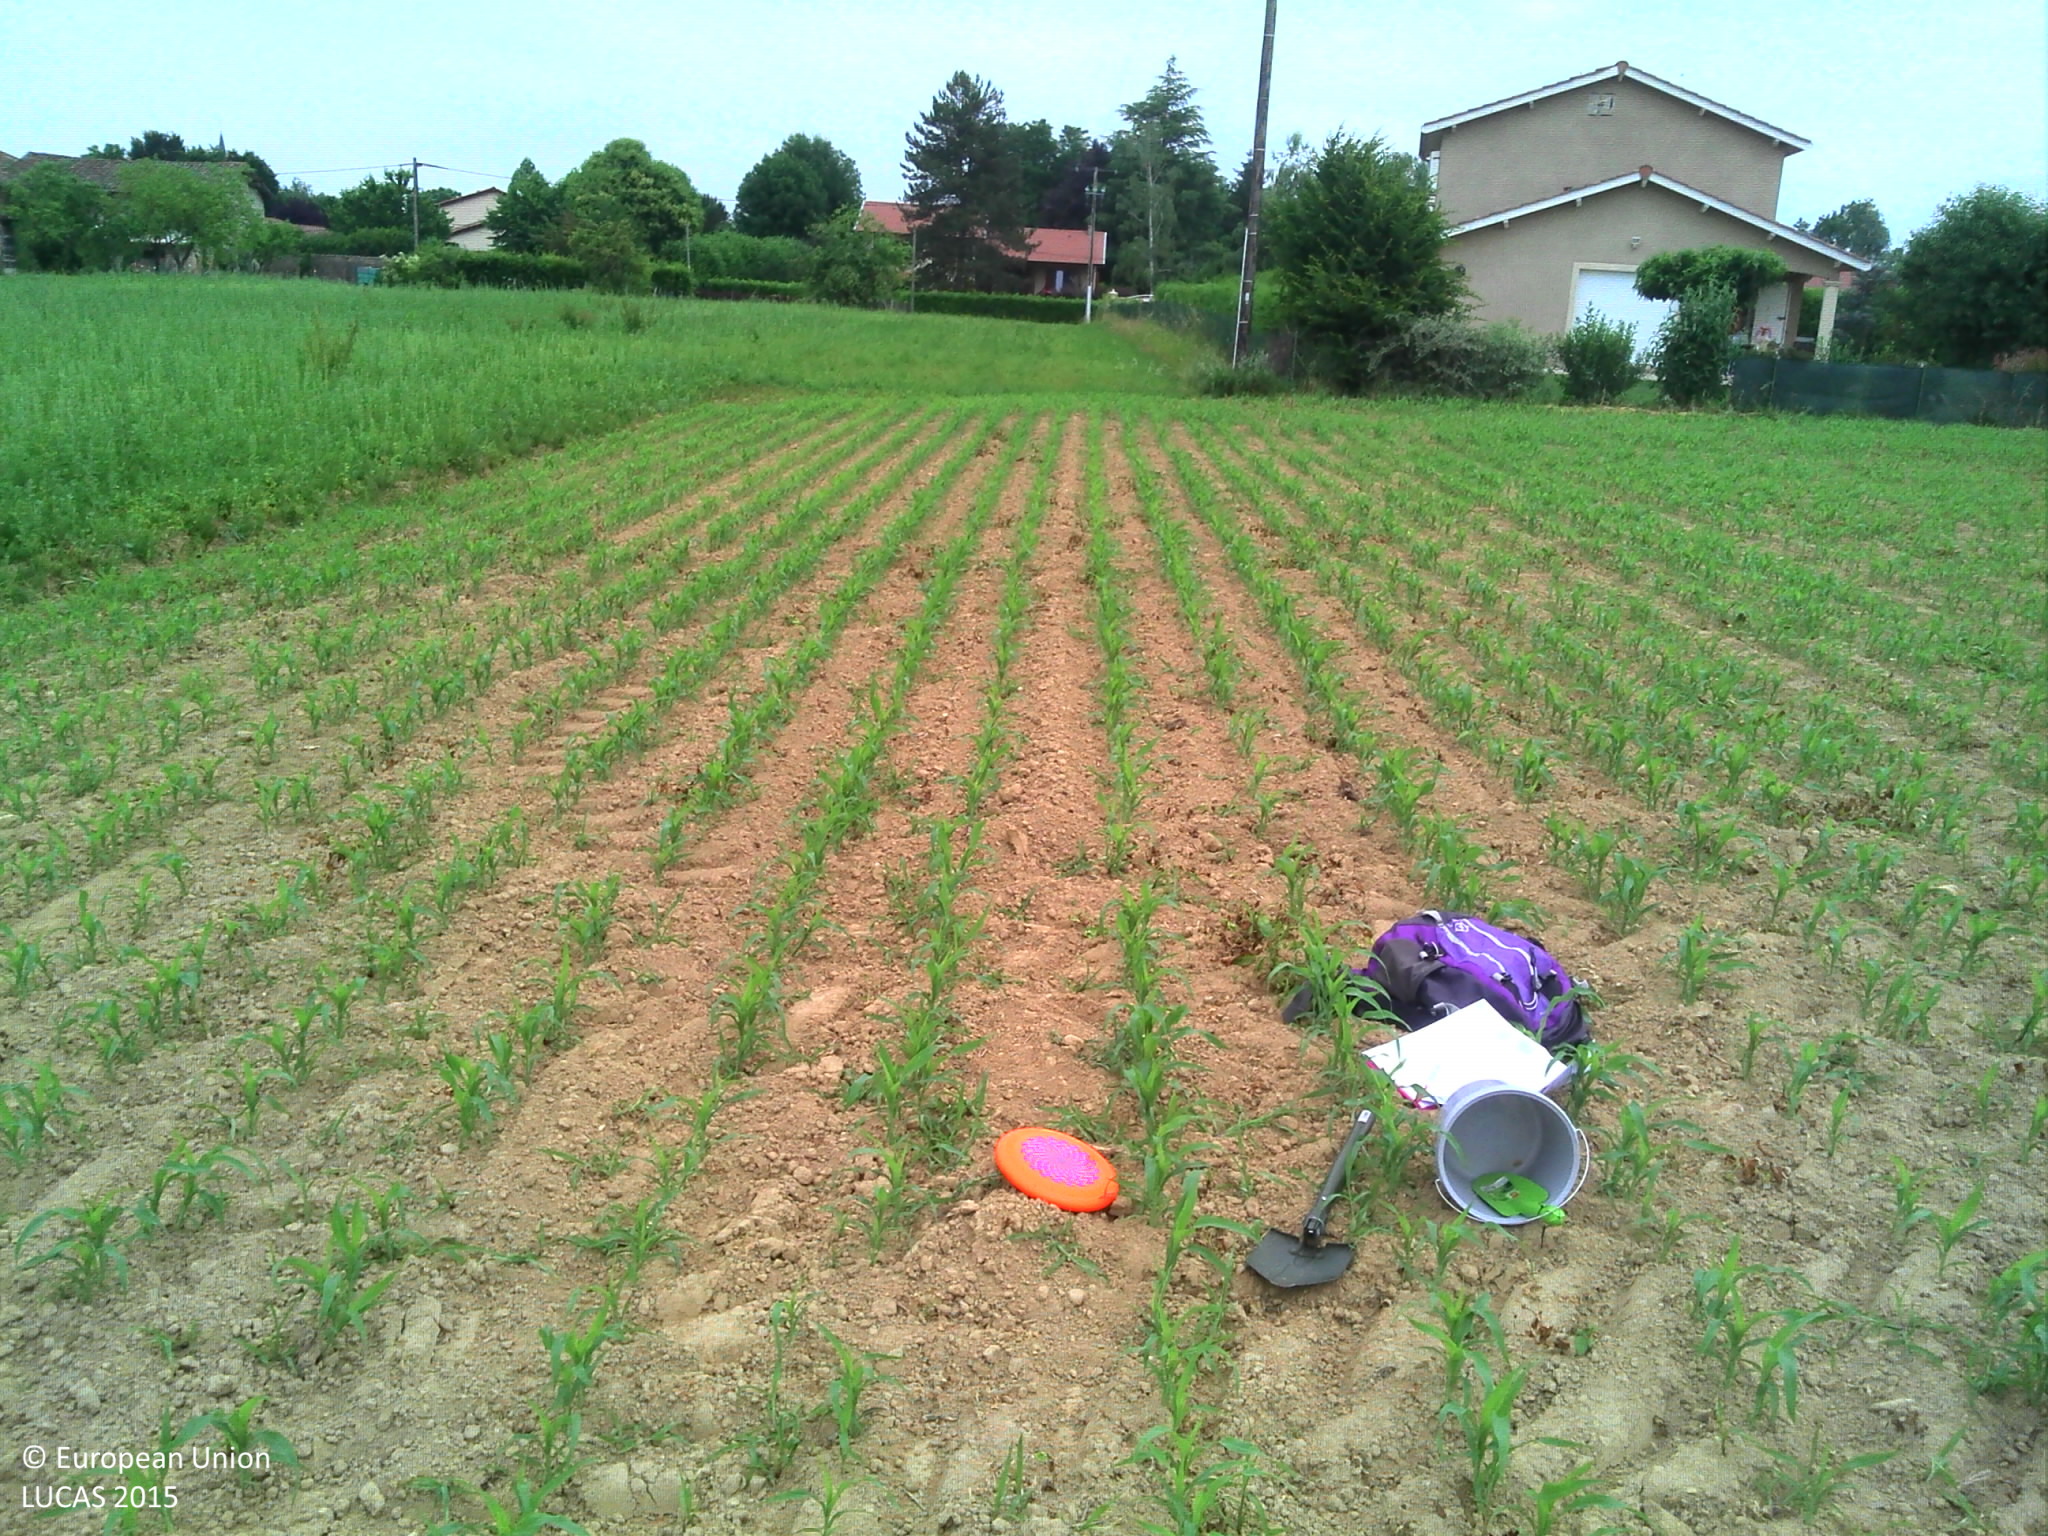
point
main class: Cropland
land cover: Maize
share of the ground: 25 - 50 %
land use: Agriculture (excluding fallow land and kitchen gardens)
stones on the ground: < 10 %
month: June
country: FR
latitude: 46.1351
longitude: 4.8121
